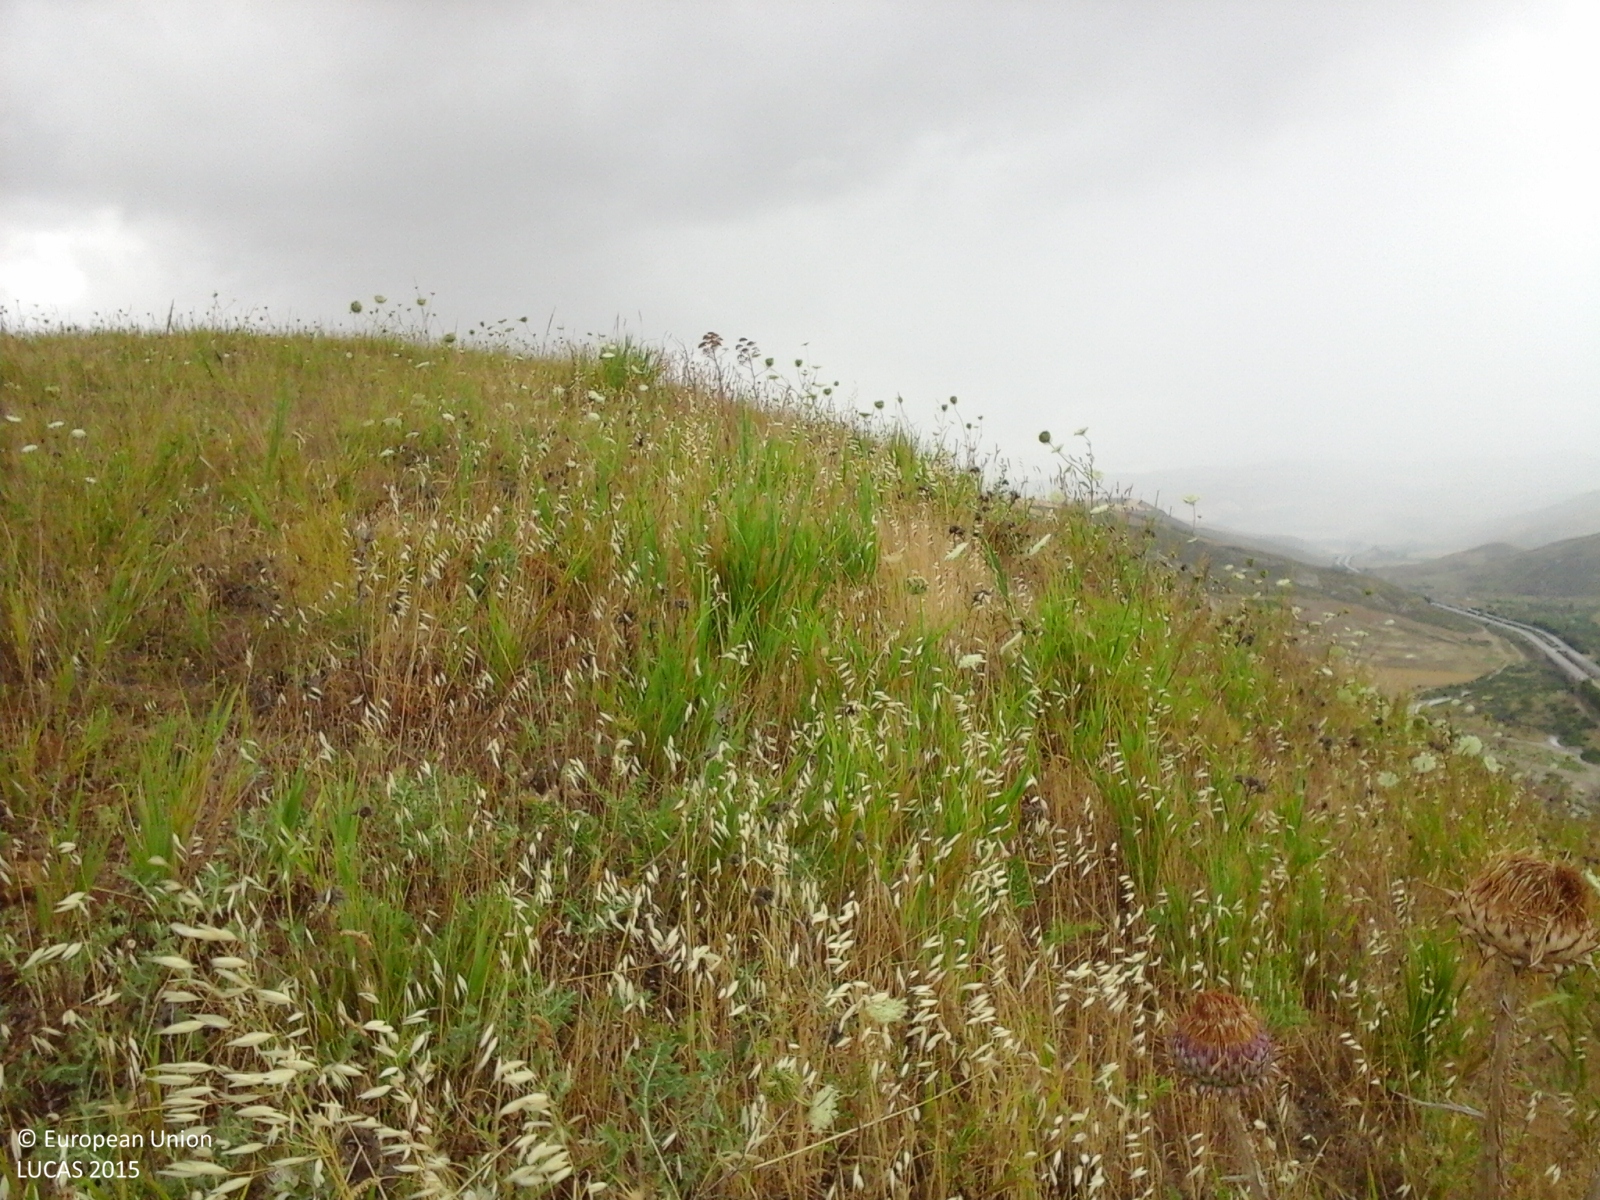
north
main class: Grassland
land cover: Grassland without tree/shrub cover
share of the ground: > 75 %
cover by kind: herbaceous plants 70 %, consolidated bare surface 20 %, unconsolidated bare surface 10 %
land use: Agriculture (excluding fallow land and kitchen gardens)
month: June
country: IT
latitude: 37.6034
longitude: 14.1268
